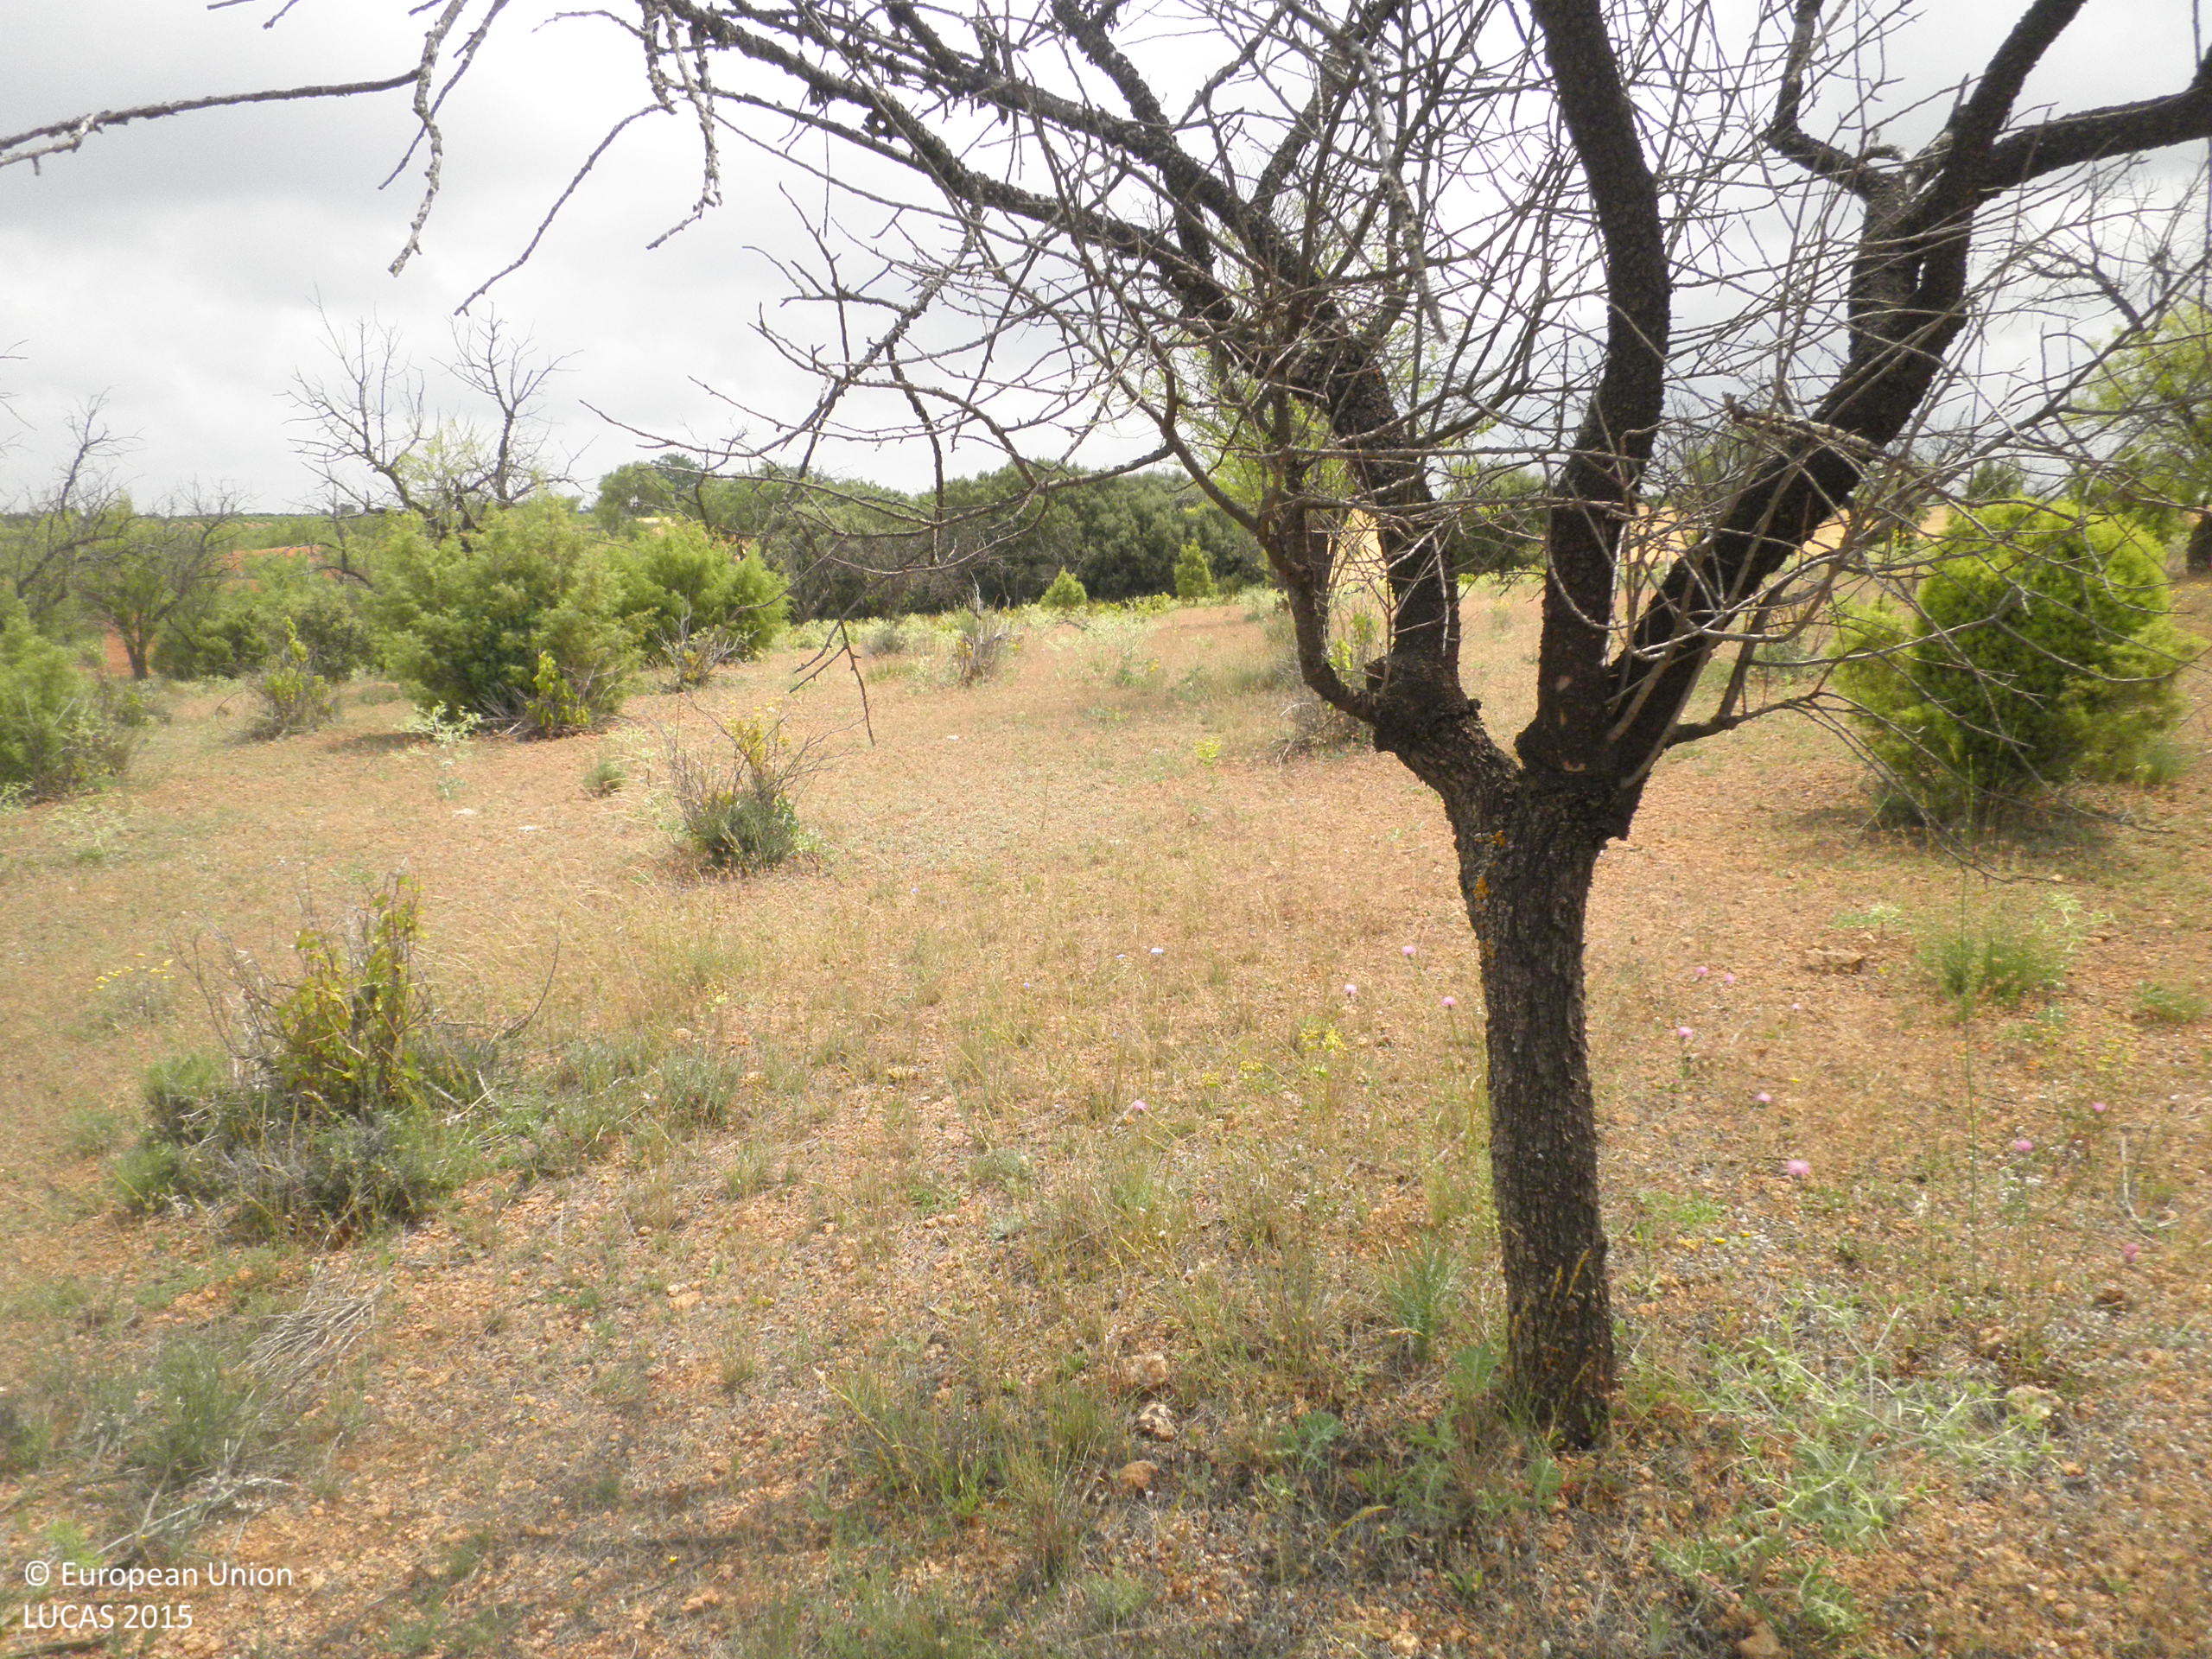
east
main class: Cropland
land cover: Nuts trees
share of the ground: < 10 %
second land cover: Grassland without tree/shrub cover
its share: 50 - 75 %
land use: Abandoned areas
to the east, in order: Nuts trees; Grassland without tree/shrub cover; Barley; Grass margins; Tracks; Grass margins; Vineyards
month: June
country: ES
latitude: 39.5519
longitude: -1.6550
